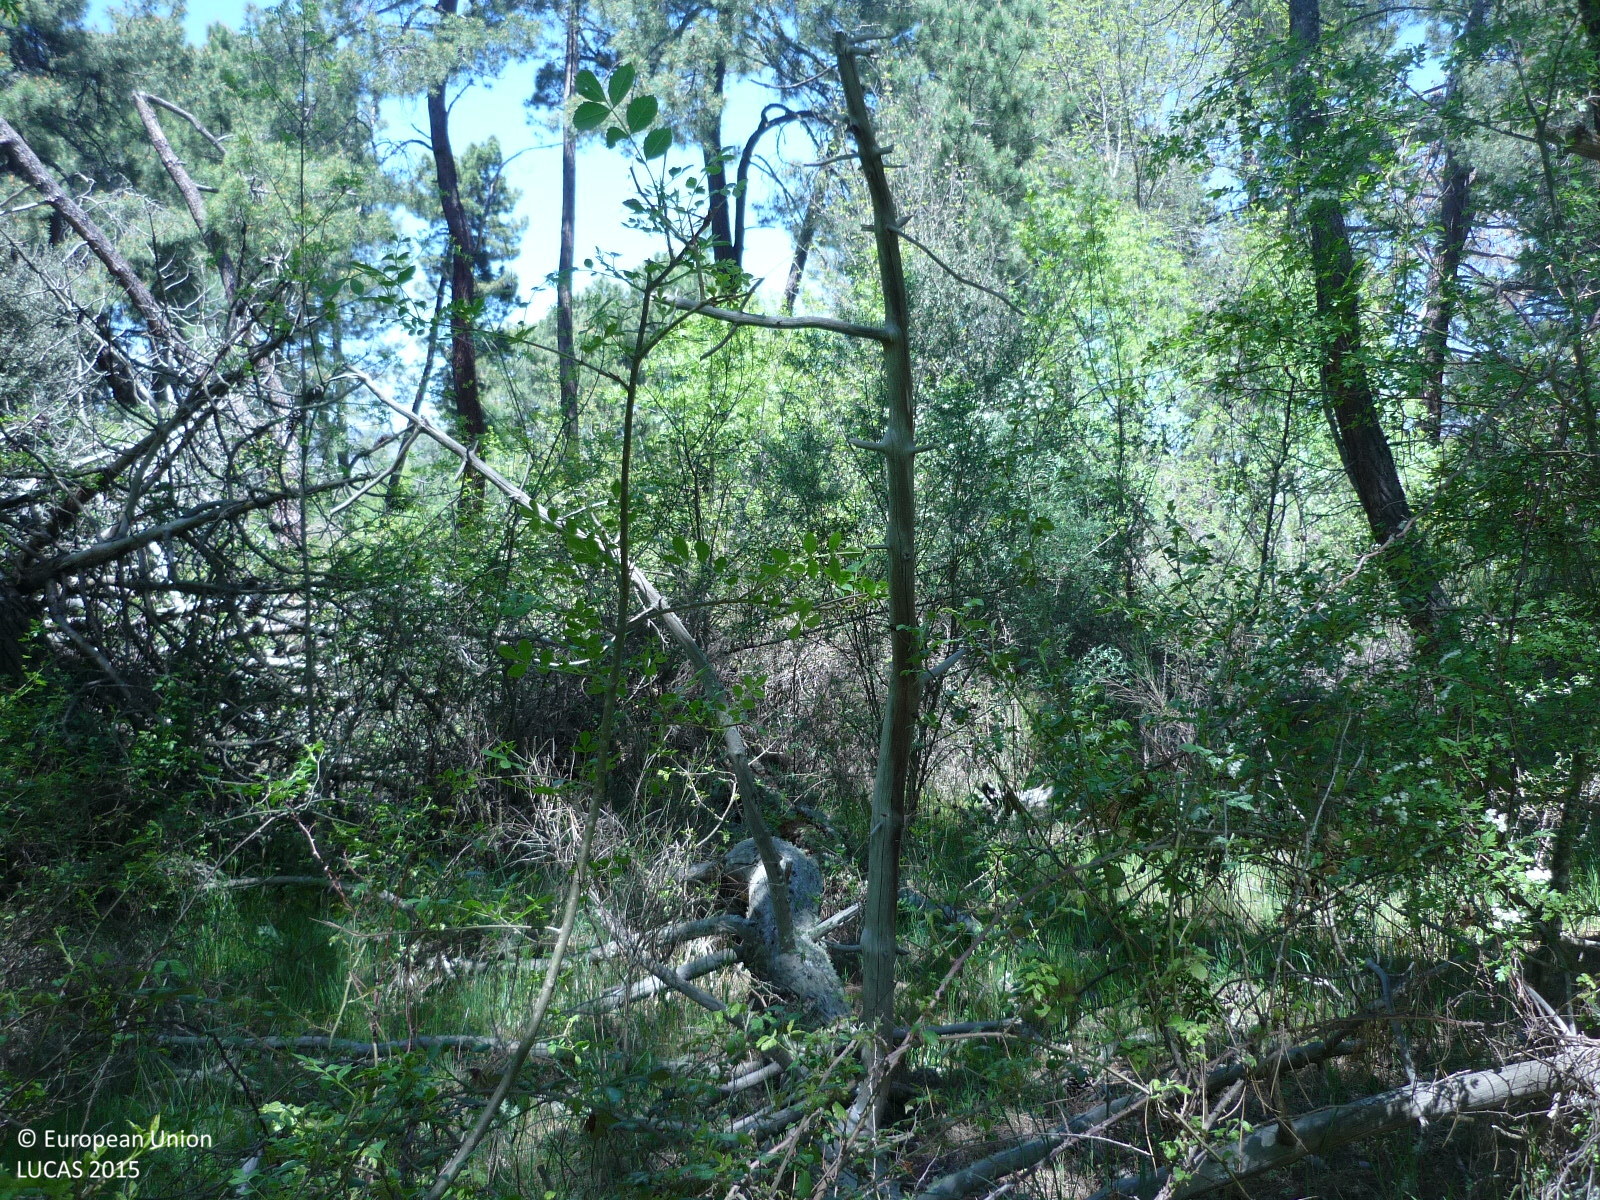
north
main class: Woodland
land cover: Broadleaved woodland
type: thermophilous deciduous forest
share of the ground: > 75 %
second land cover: Grassland without tree/shrub cover
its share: > 75 %
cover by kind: broadleaved forest trees 90 %, herbaceous plants 10 %
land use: Forestry
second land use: Agriculture (excluding fallow land and kitchen gardens)
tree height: < 5 m
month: May
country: ES
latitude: 40.9812
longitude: -3.6042
